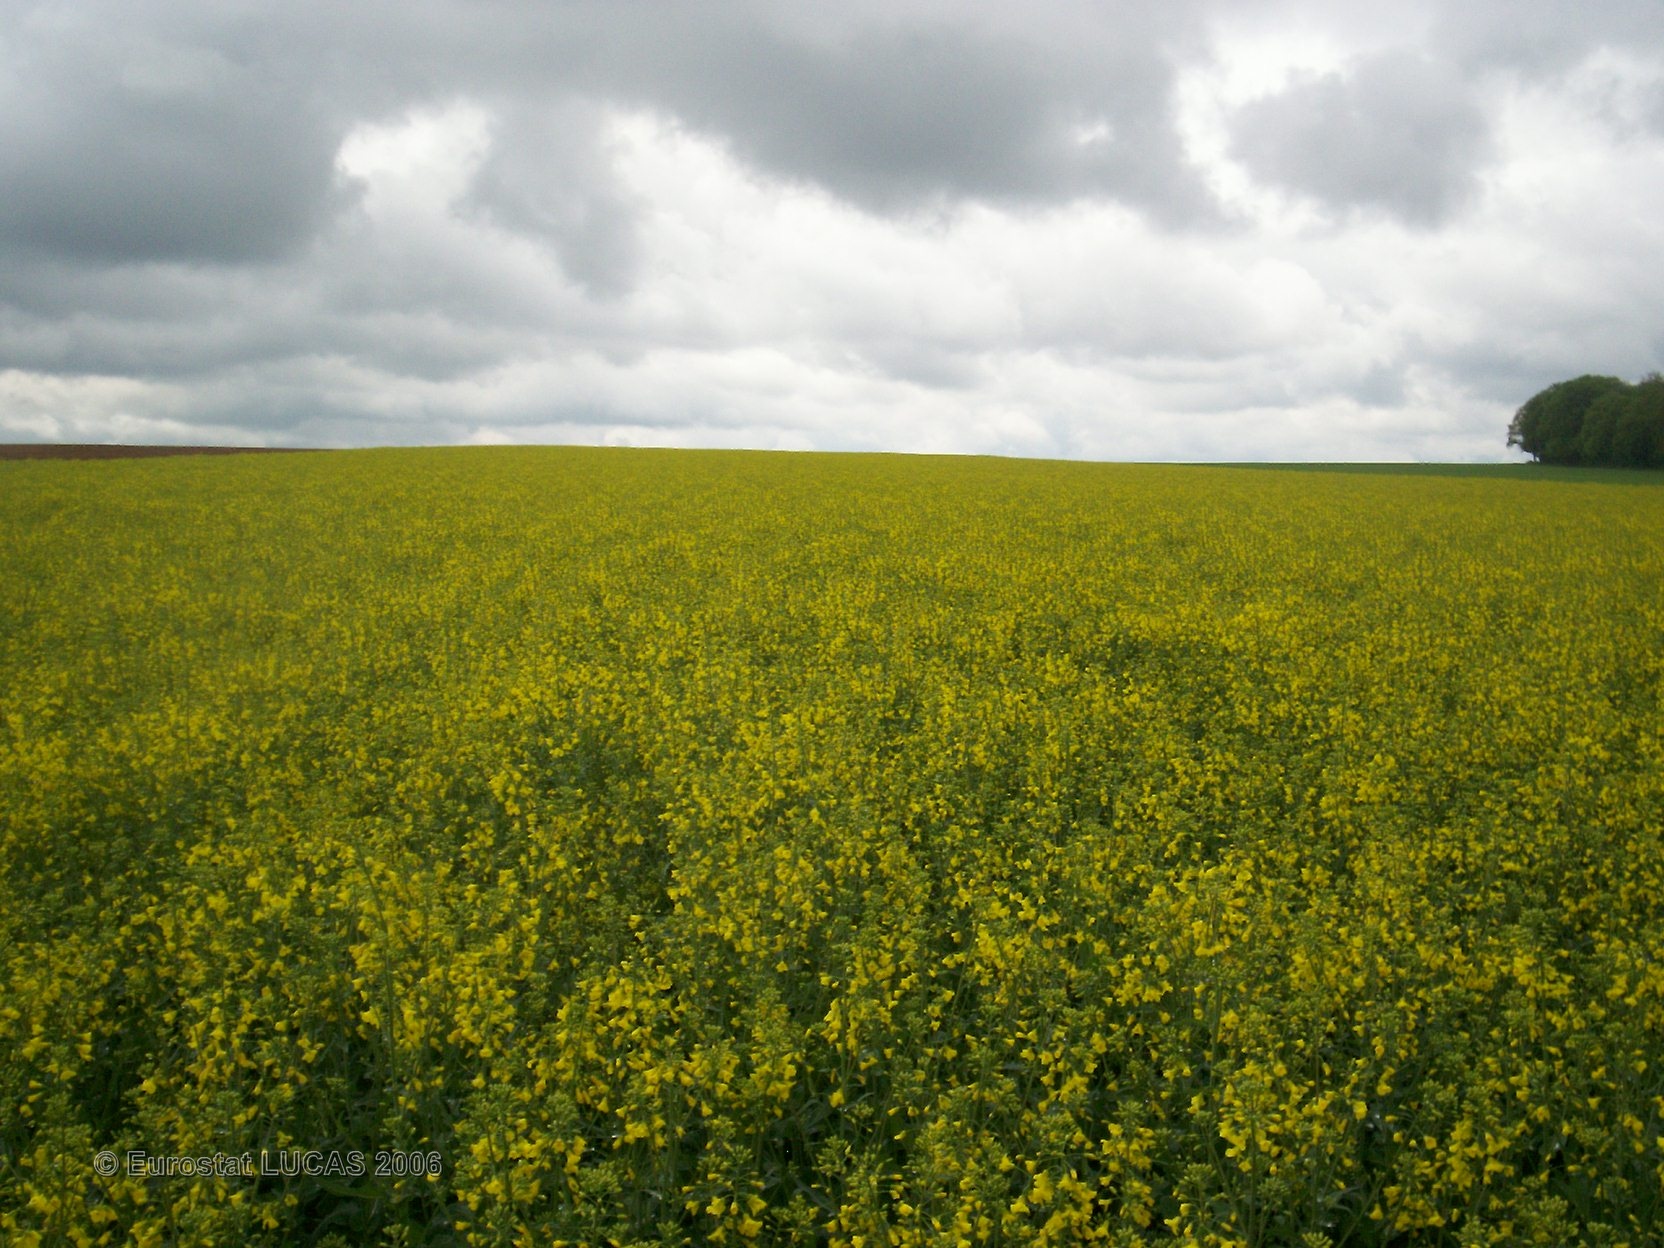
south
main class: Cropland
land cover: Rape and turnip rape
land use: Agriculture (excluding fallow land and kitchen gardens)
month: May
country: FR
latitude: 47.7843
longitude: 4.5931
